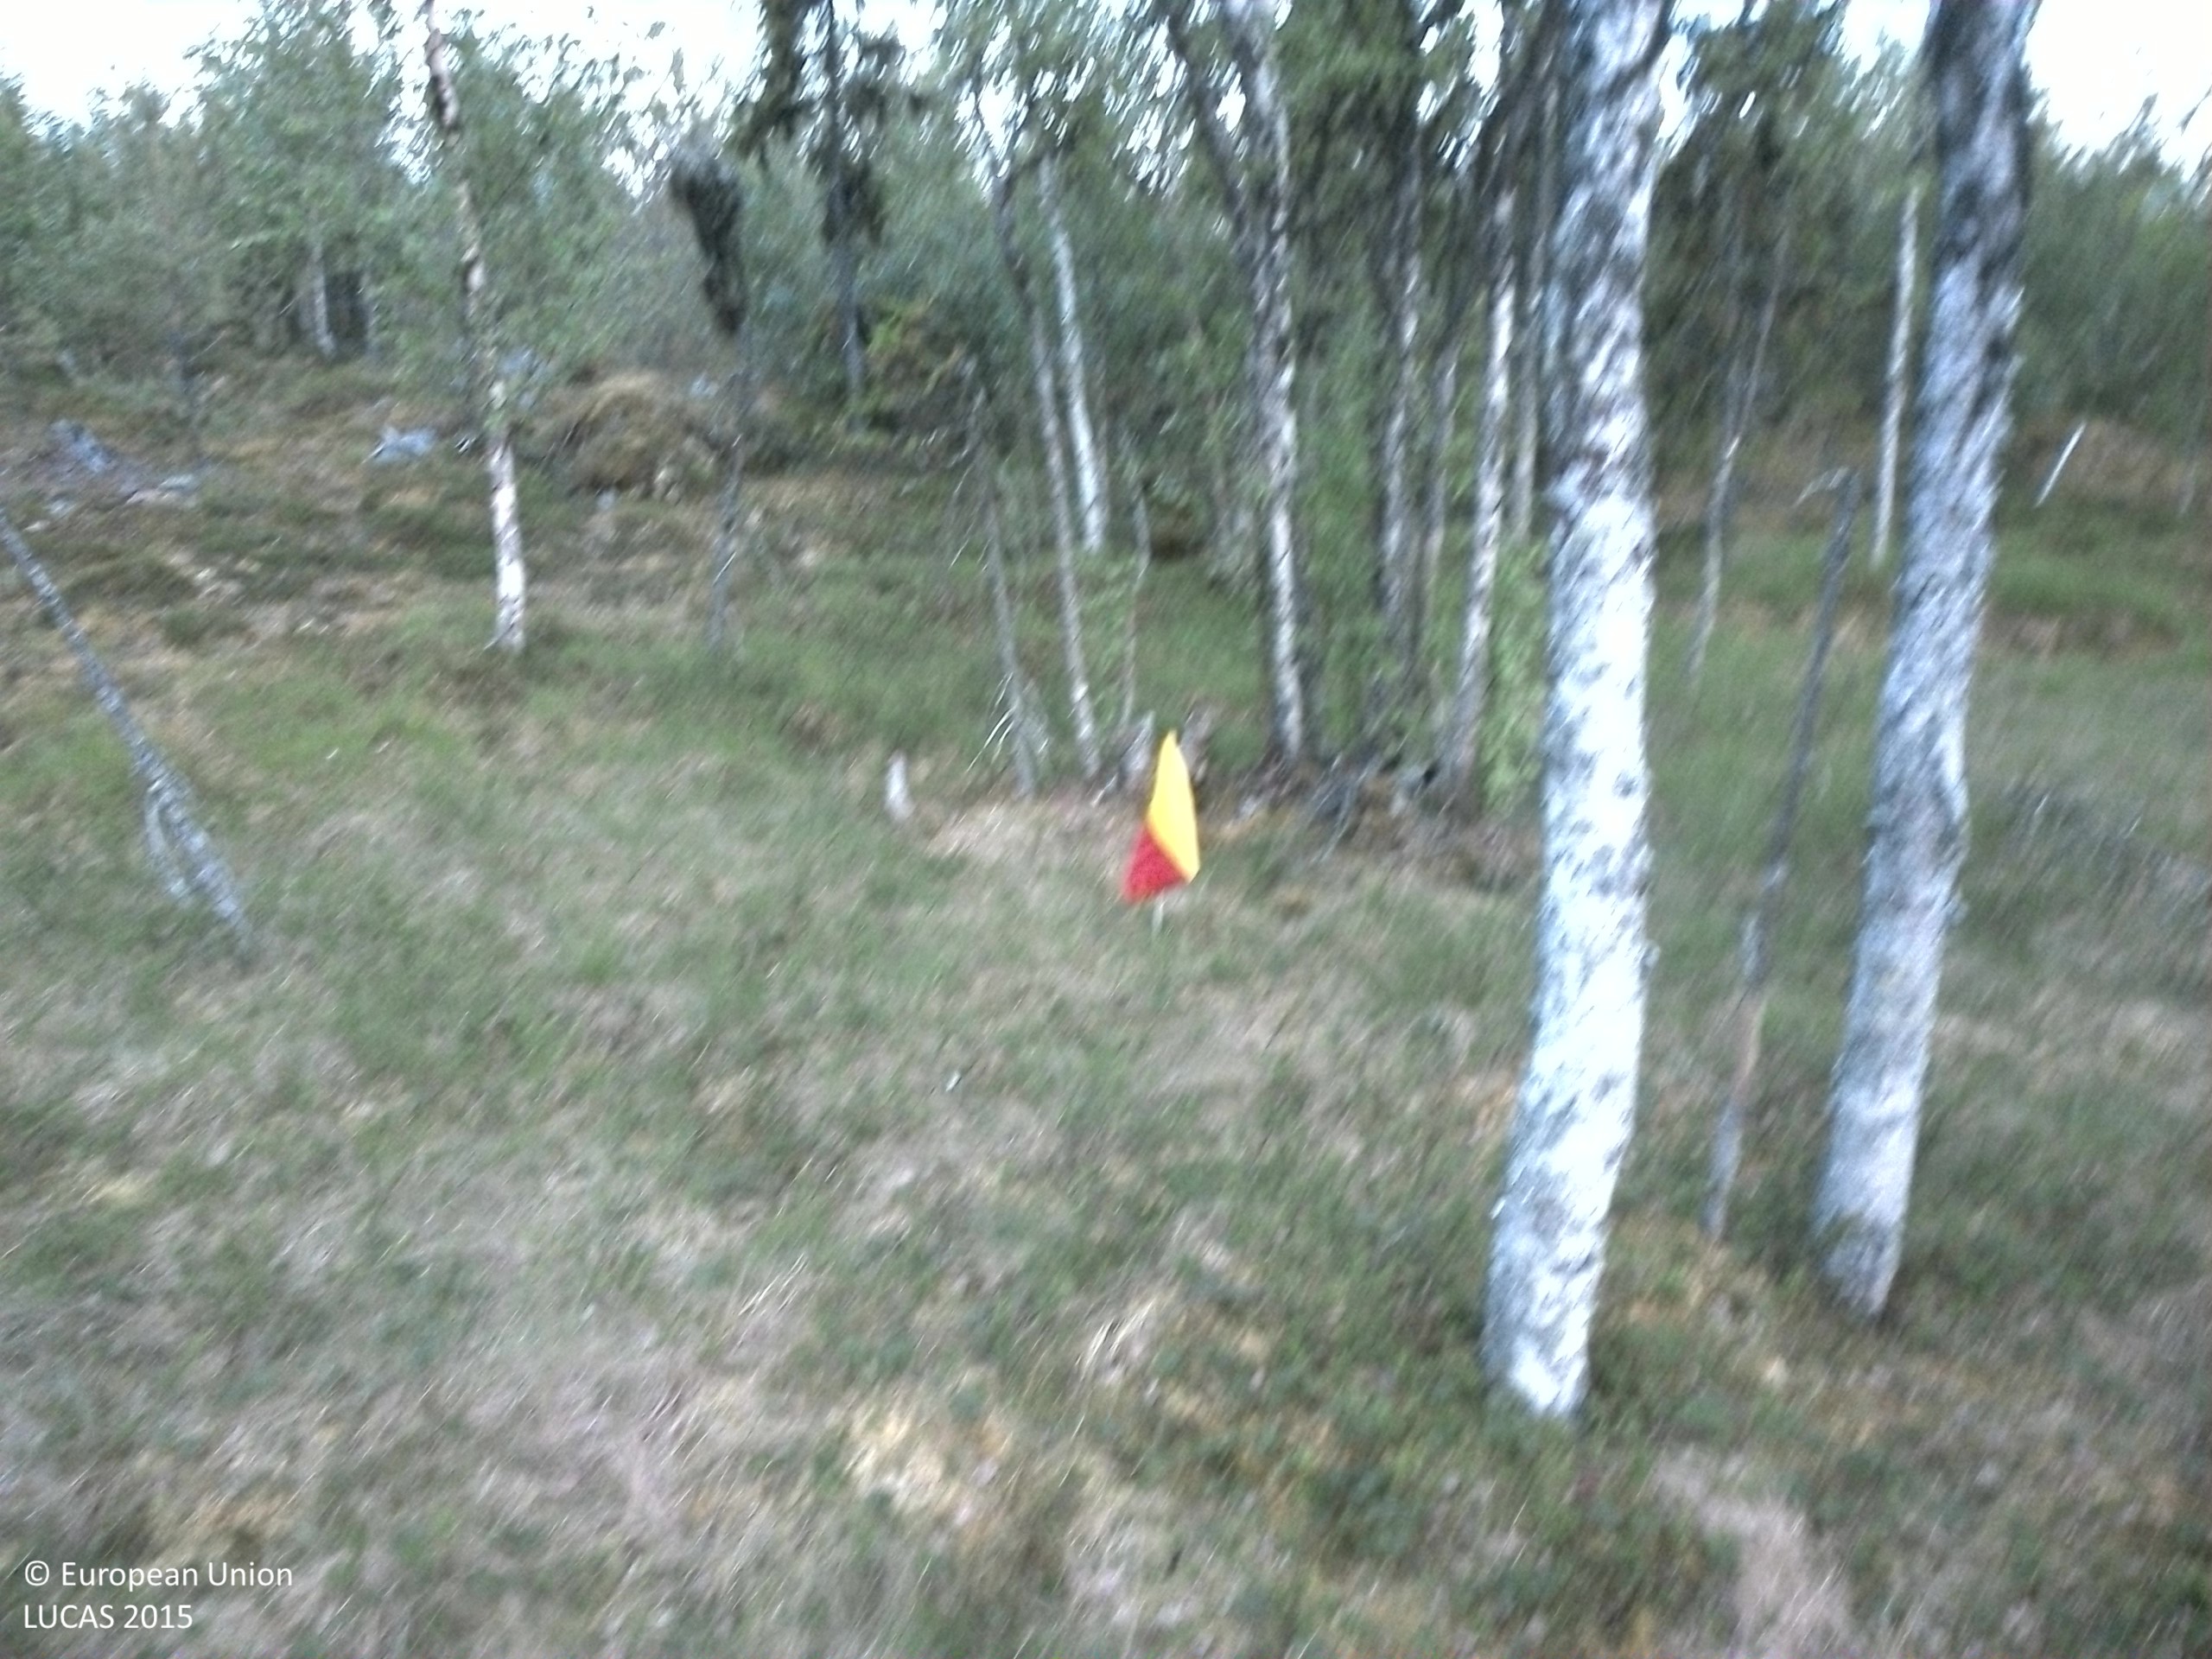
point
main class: Woodland
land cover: Pine dominated mixed woodland
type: boreal forest
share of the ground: 10 - 25 %
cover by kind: herbaceous plants 35 %, shrubs 25 %, coniferous forest trees 15 %, lichens and mosses 15 %, broadleaved forest trees 10 %
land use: Forestry
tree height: > 5 m
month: July
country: SE
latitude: 64.2824
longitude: 16.5166
